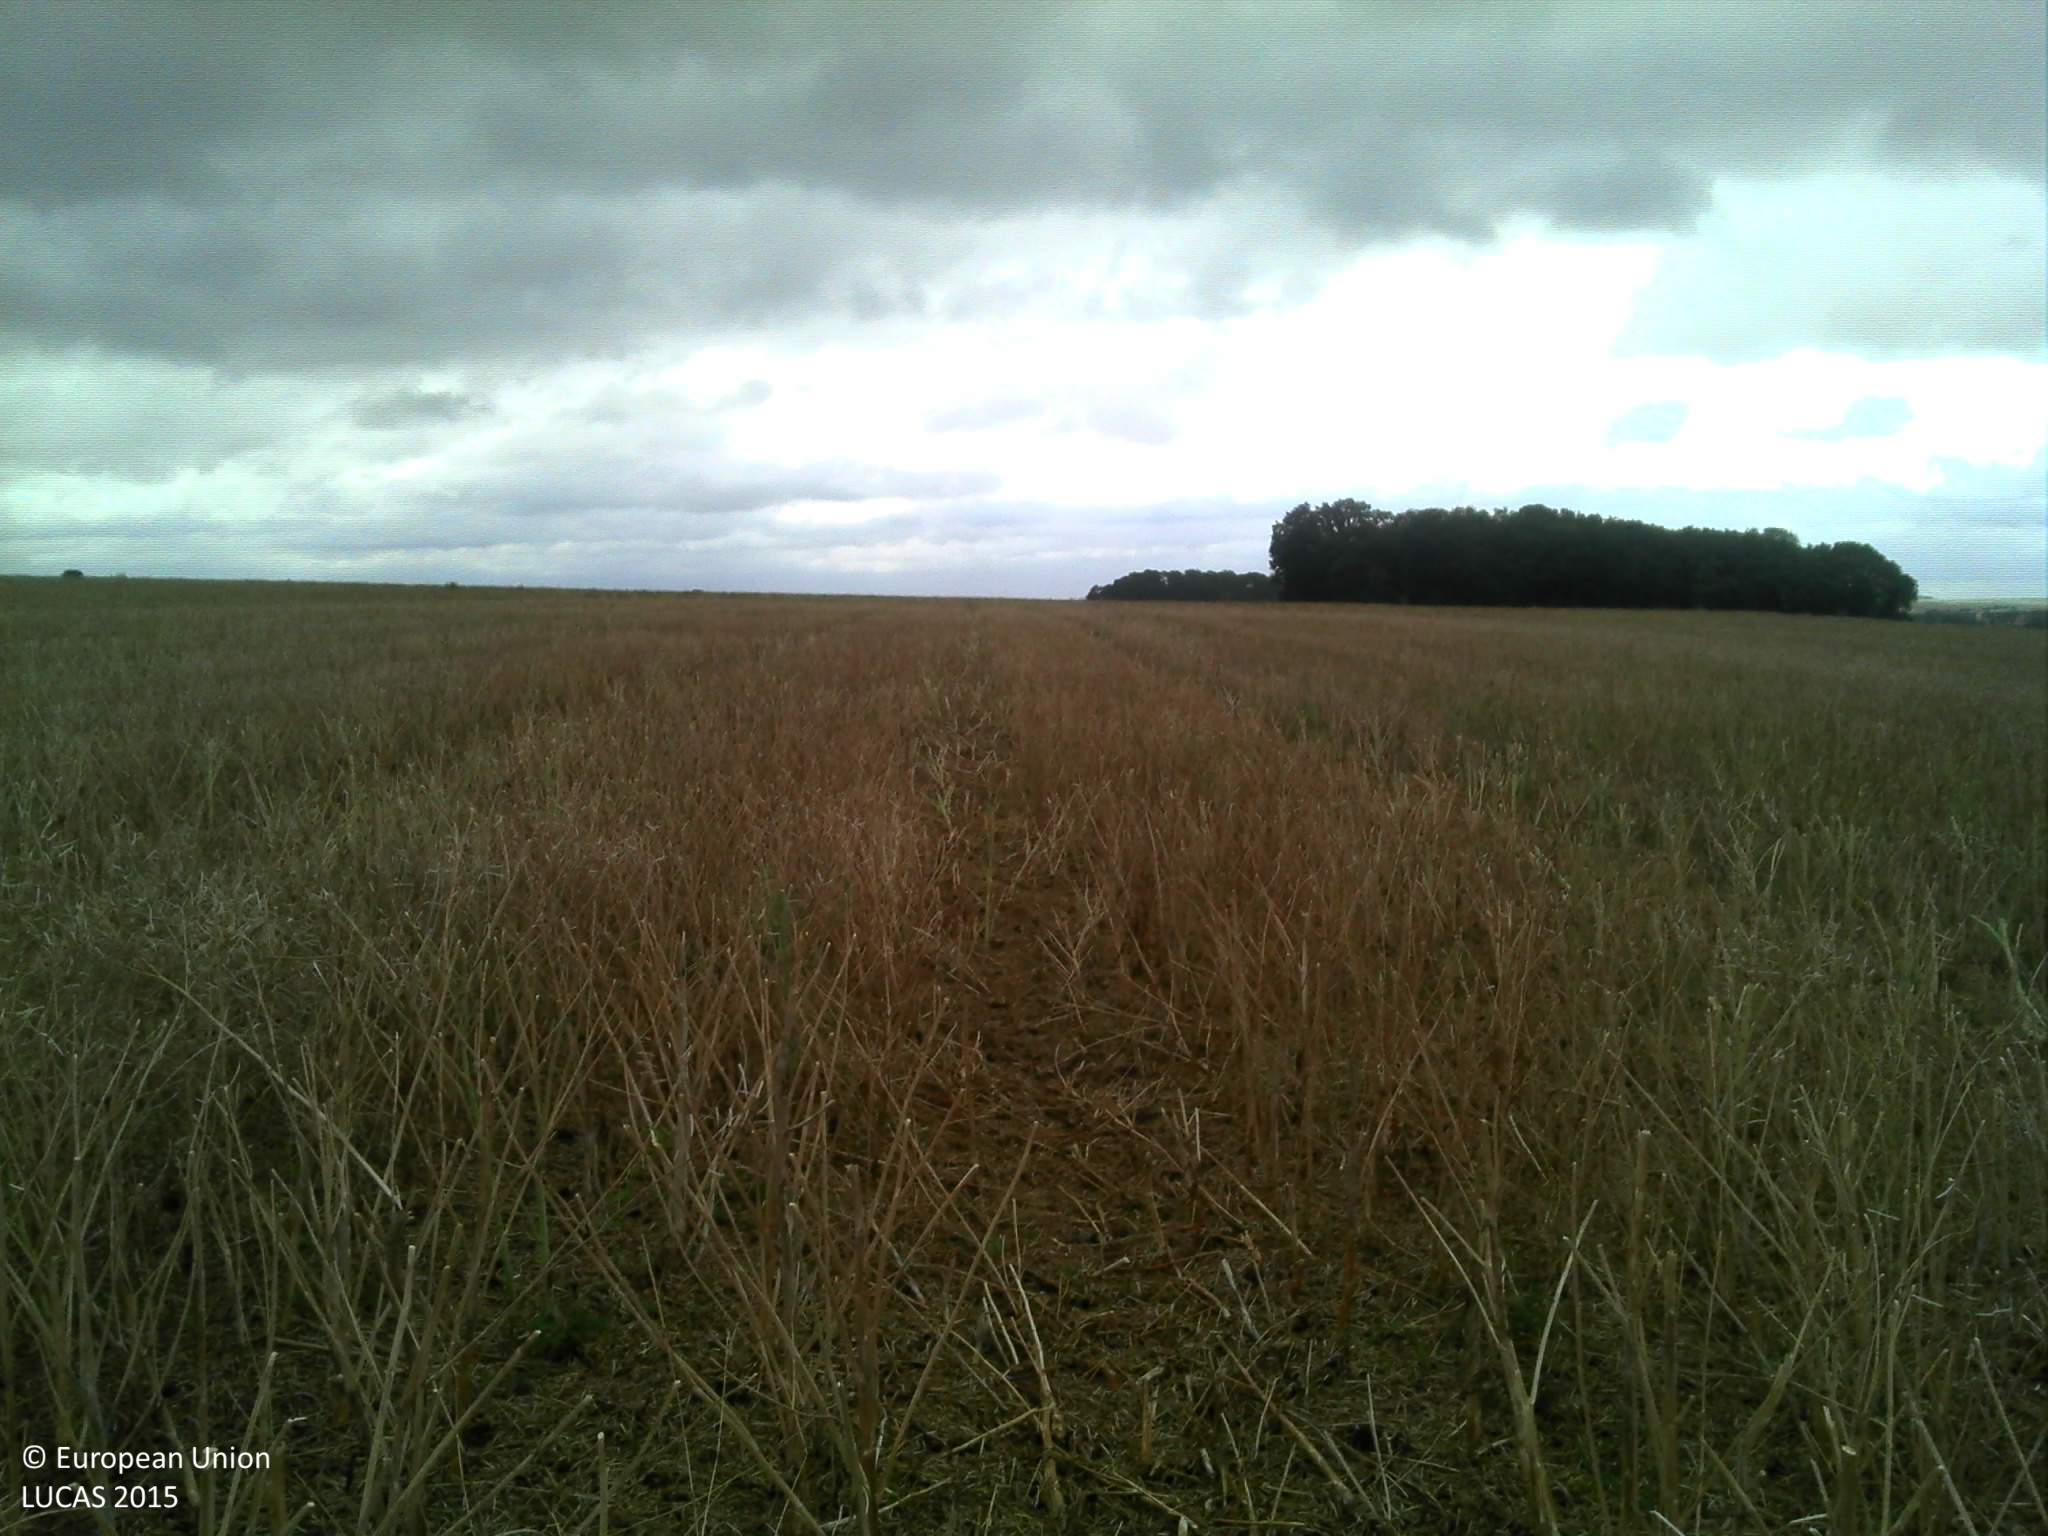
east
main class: Cropland
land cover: Rape and turnip rape
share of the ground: 25 - 50 %
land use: Agriculture (excluding fallow land and kitchen gardens)
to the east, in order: Rape and turnip rape; Durum wheat
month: July
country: FR
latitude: 49.8283
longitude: 2.4948
